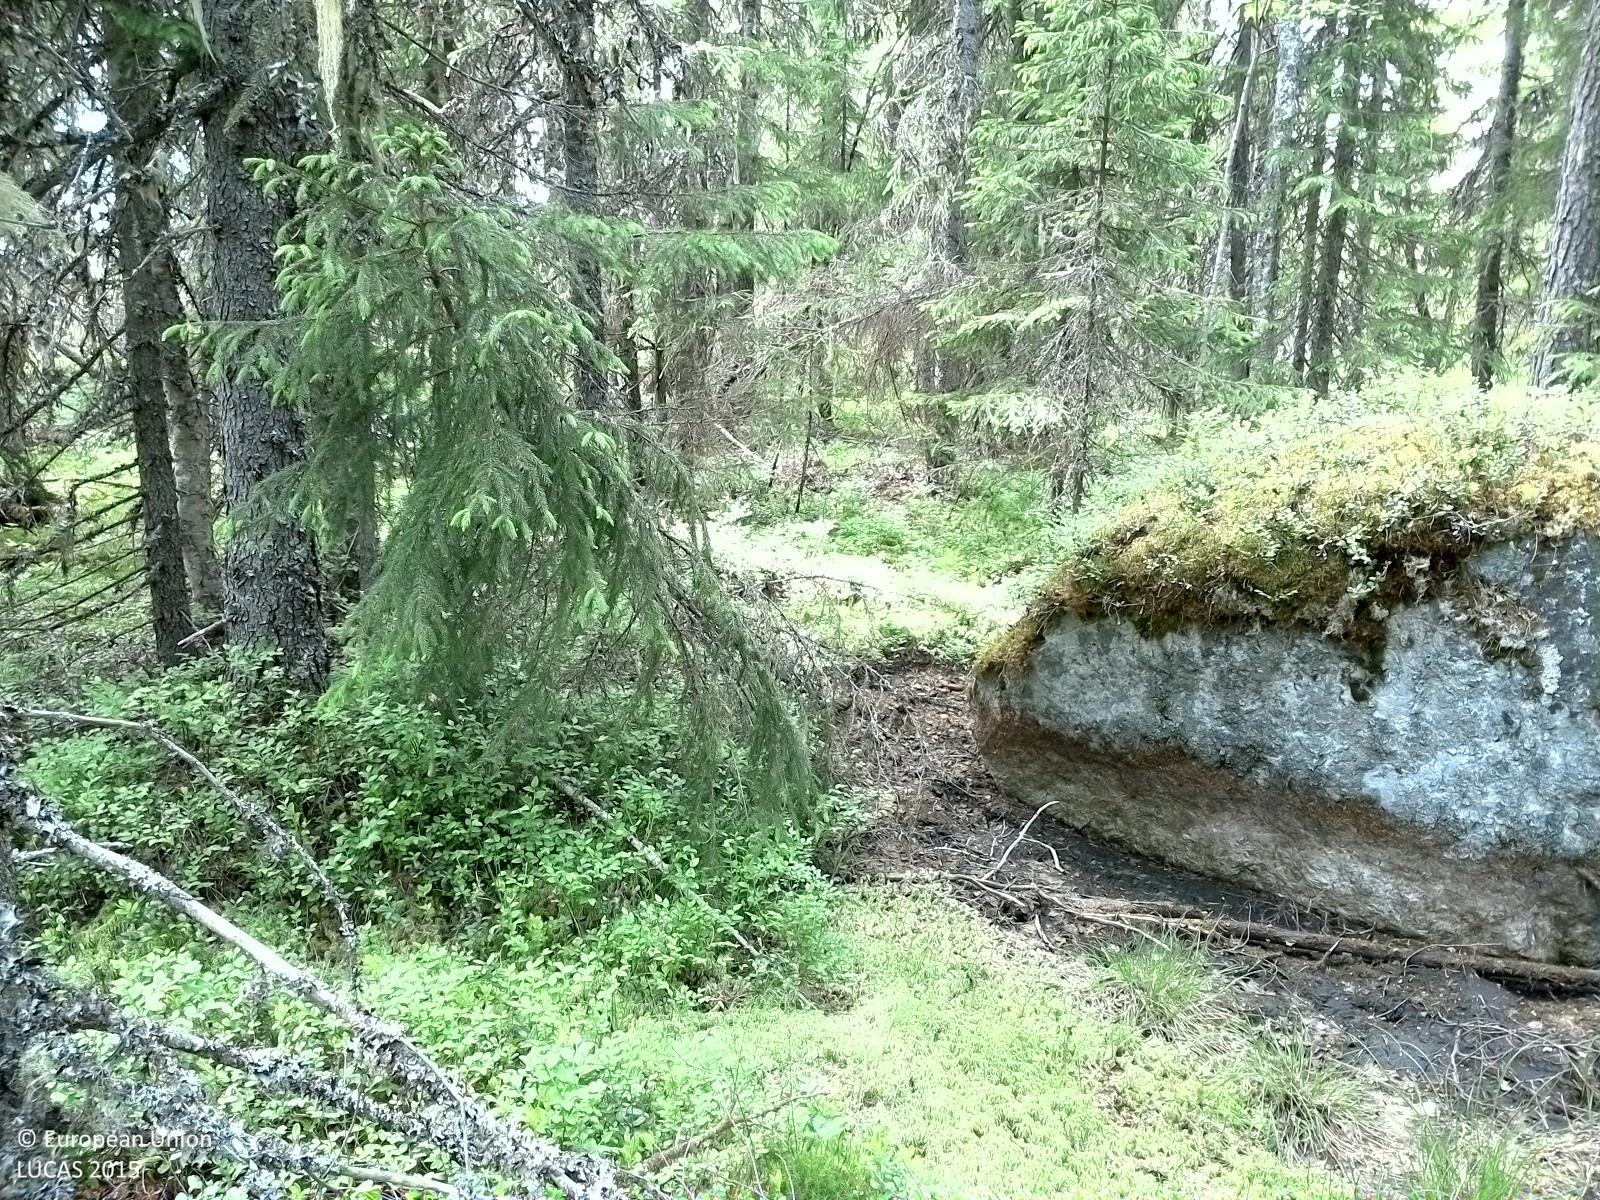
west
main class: Woodland
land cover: Spruce dominated coniferous woodland
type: boreal forest
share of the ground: 25 - 50 %
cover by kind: coniferous forest trees 40 %, lichens and mosses 30 %, shrubs 25 %, broadleaved forest trees 5 %
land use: Forestry
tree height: > 5 m
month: July
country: SE
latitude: 62.1495
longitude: 16.8313
